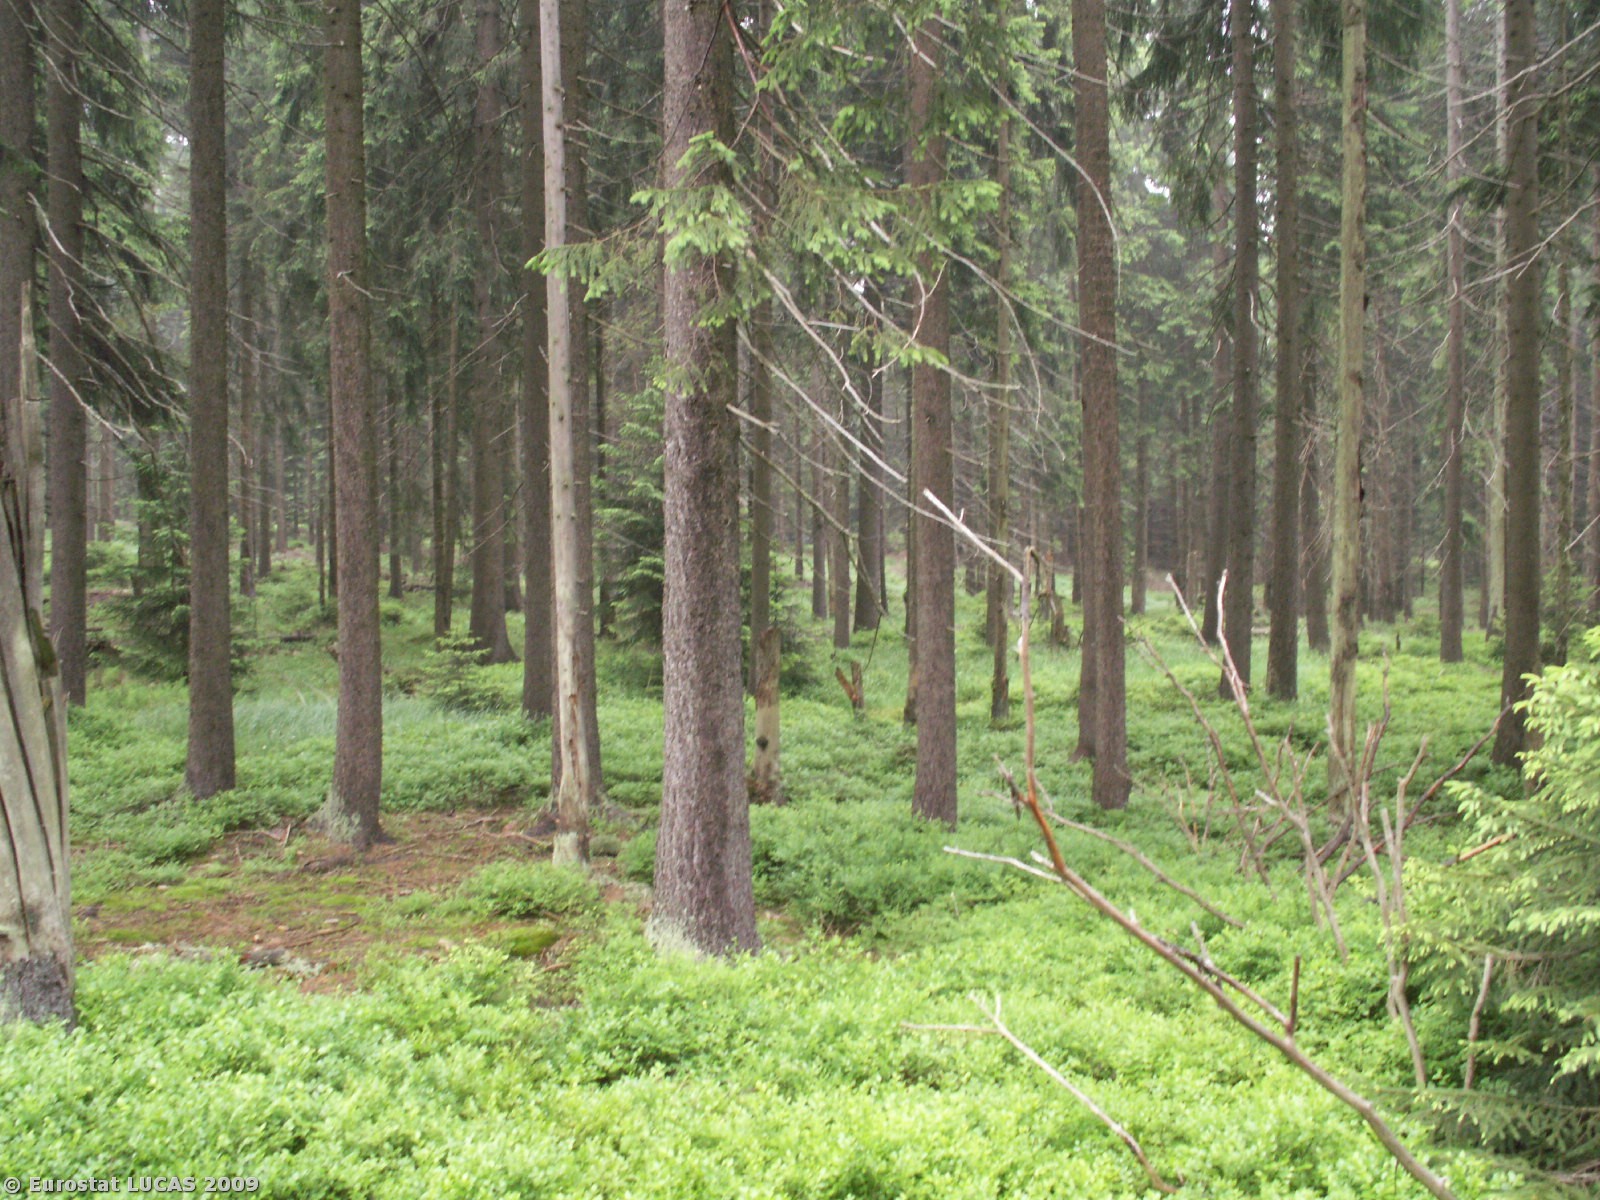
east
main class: Woodland
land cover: Coniferous woodland
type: hemiboreal forest and nemoral coniferous forest and mixed broadleaved-coniferous forest
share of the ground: > 75 %
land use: Forestry
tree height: > 5 m
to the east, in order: Coniferous woodland; Grass margins; Tracks; Ditches and canals; Coniferous woodland
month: June
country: CZ
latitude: 50.3512
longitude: 12.6560
